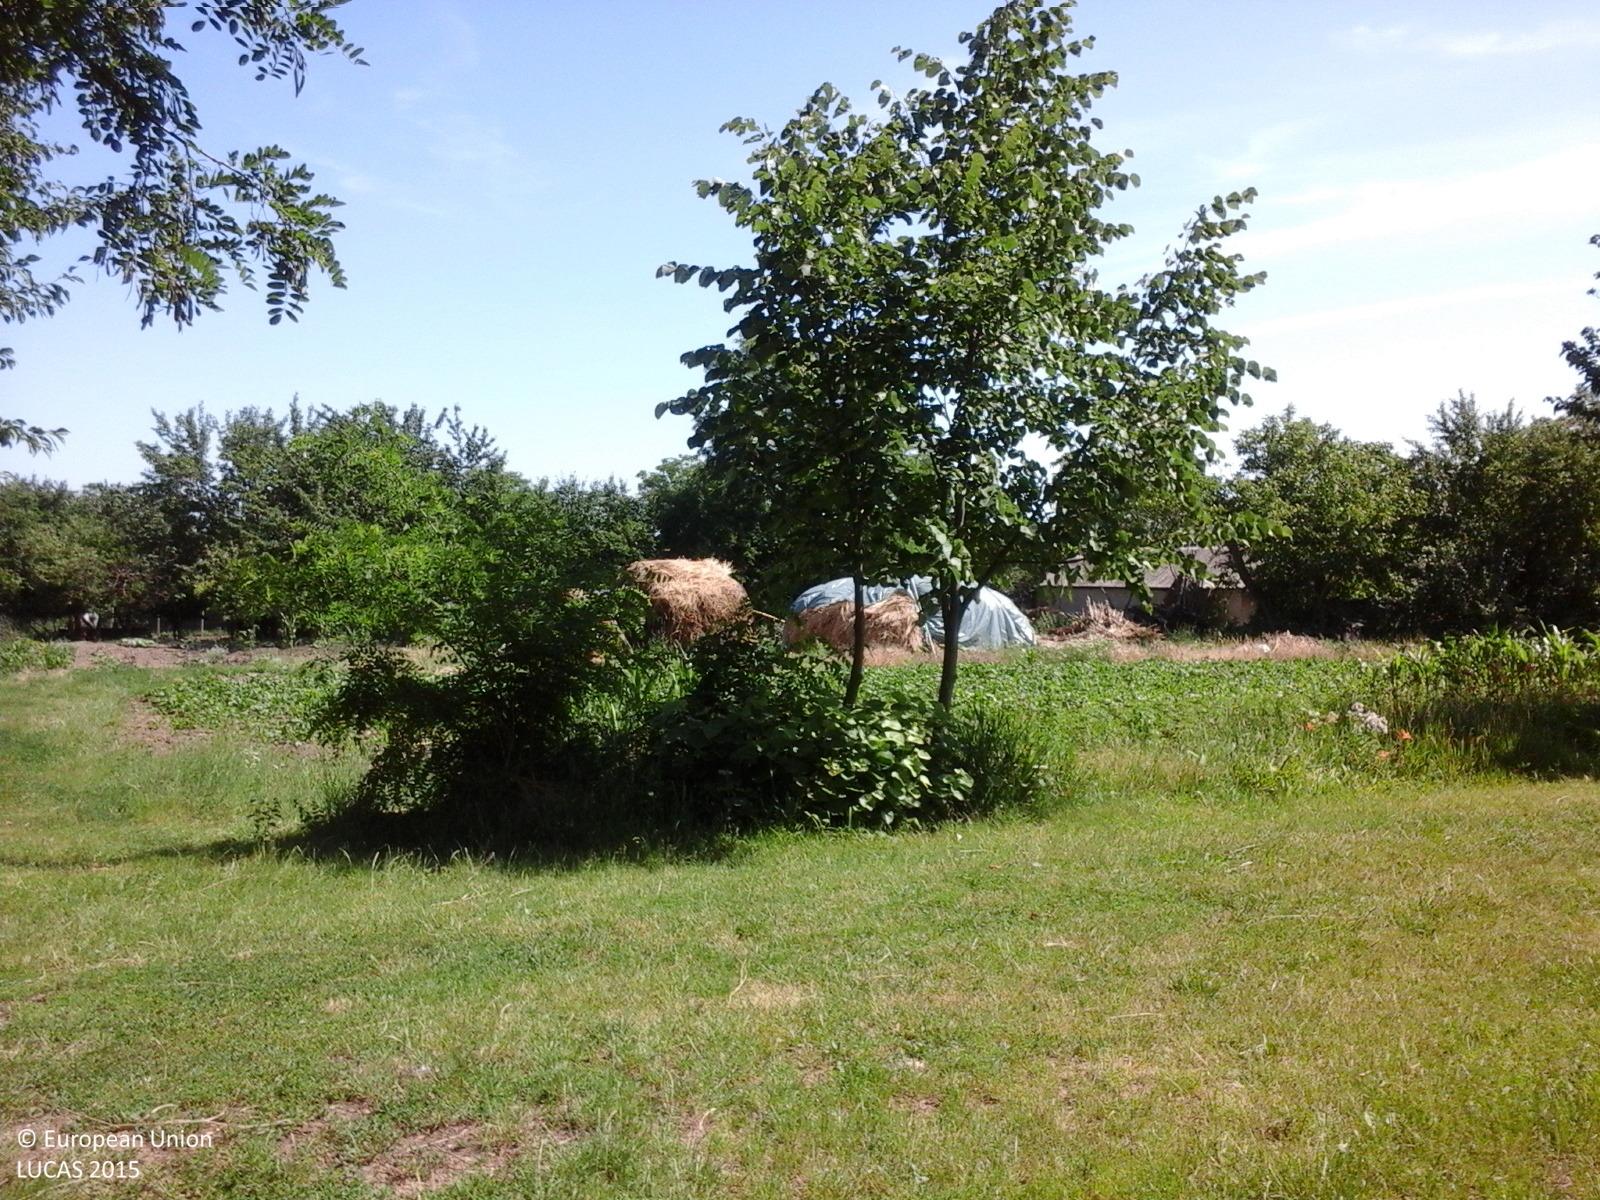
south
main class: Cropland
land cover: Cherry fruit
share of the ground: > 75 %
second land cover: Grassland without tree/shrub cover
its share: > 75 %
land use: Community services
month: June
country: RO
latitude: 47.1608
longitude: 26.9165
